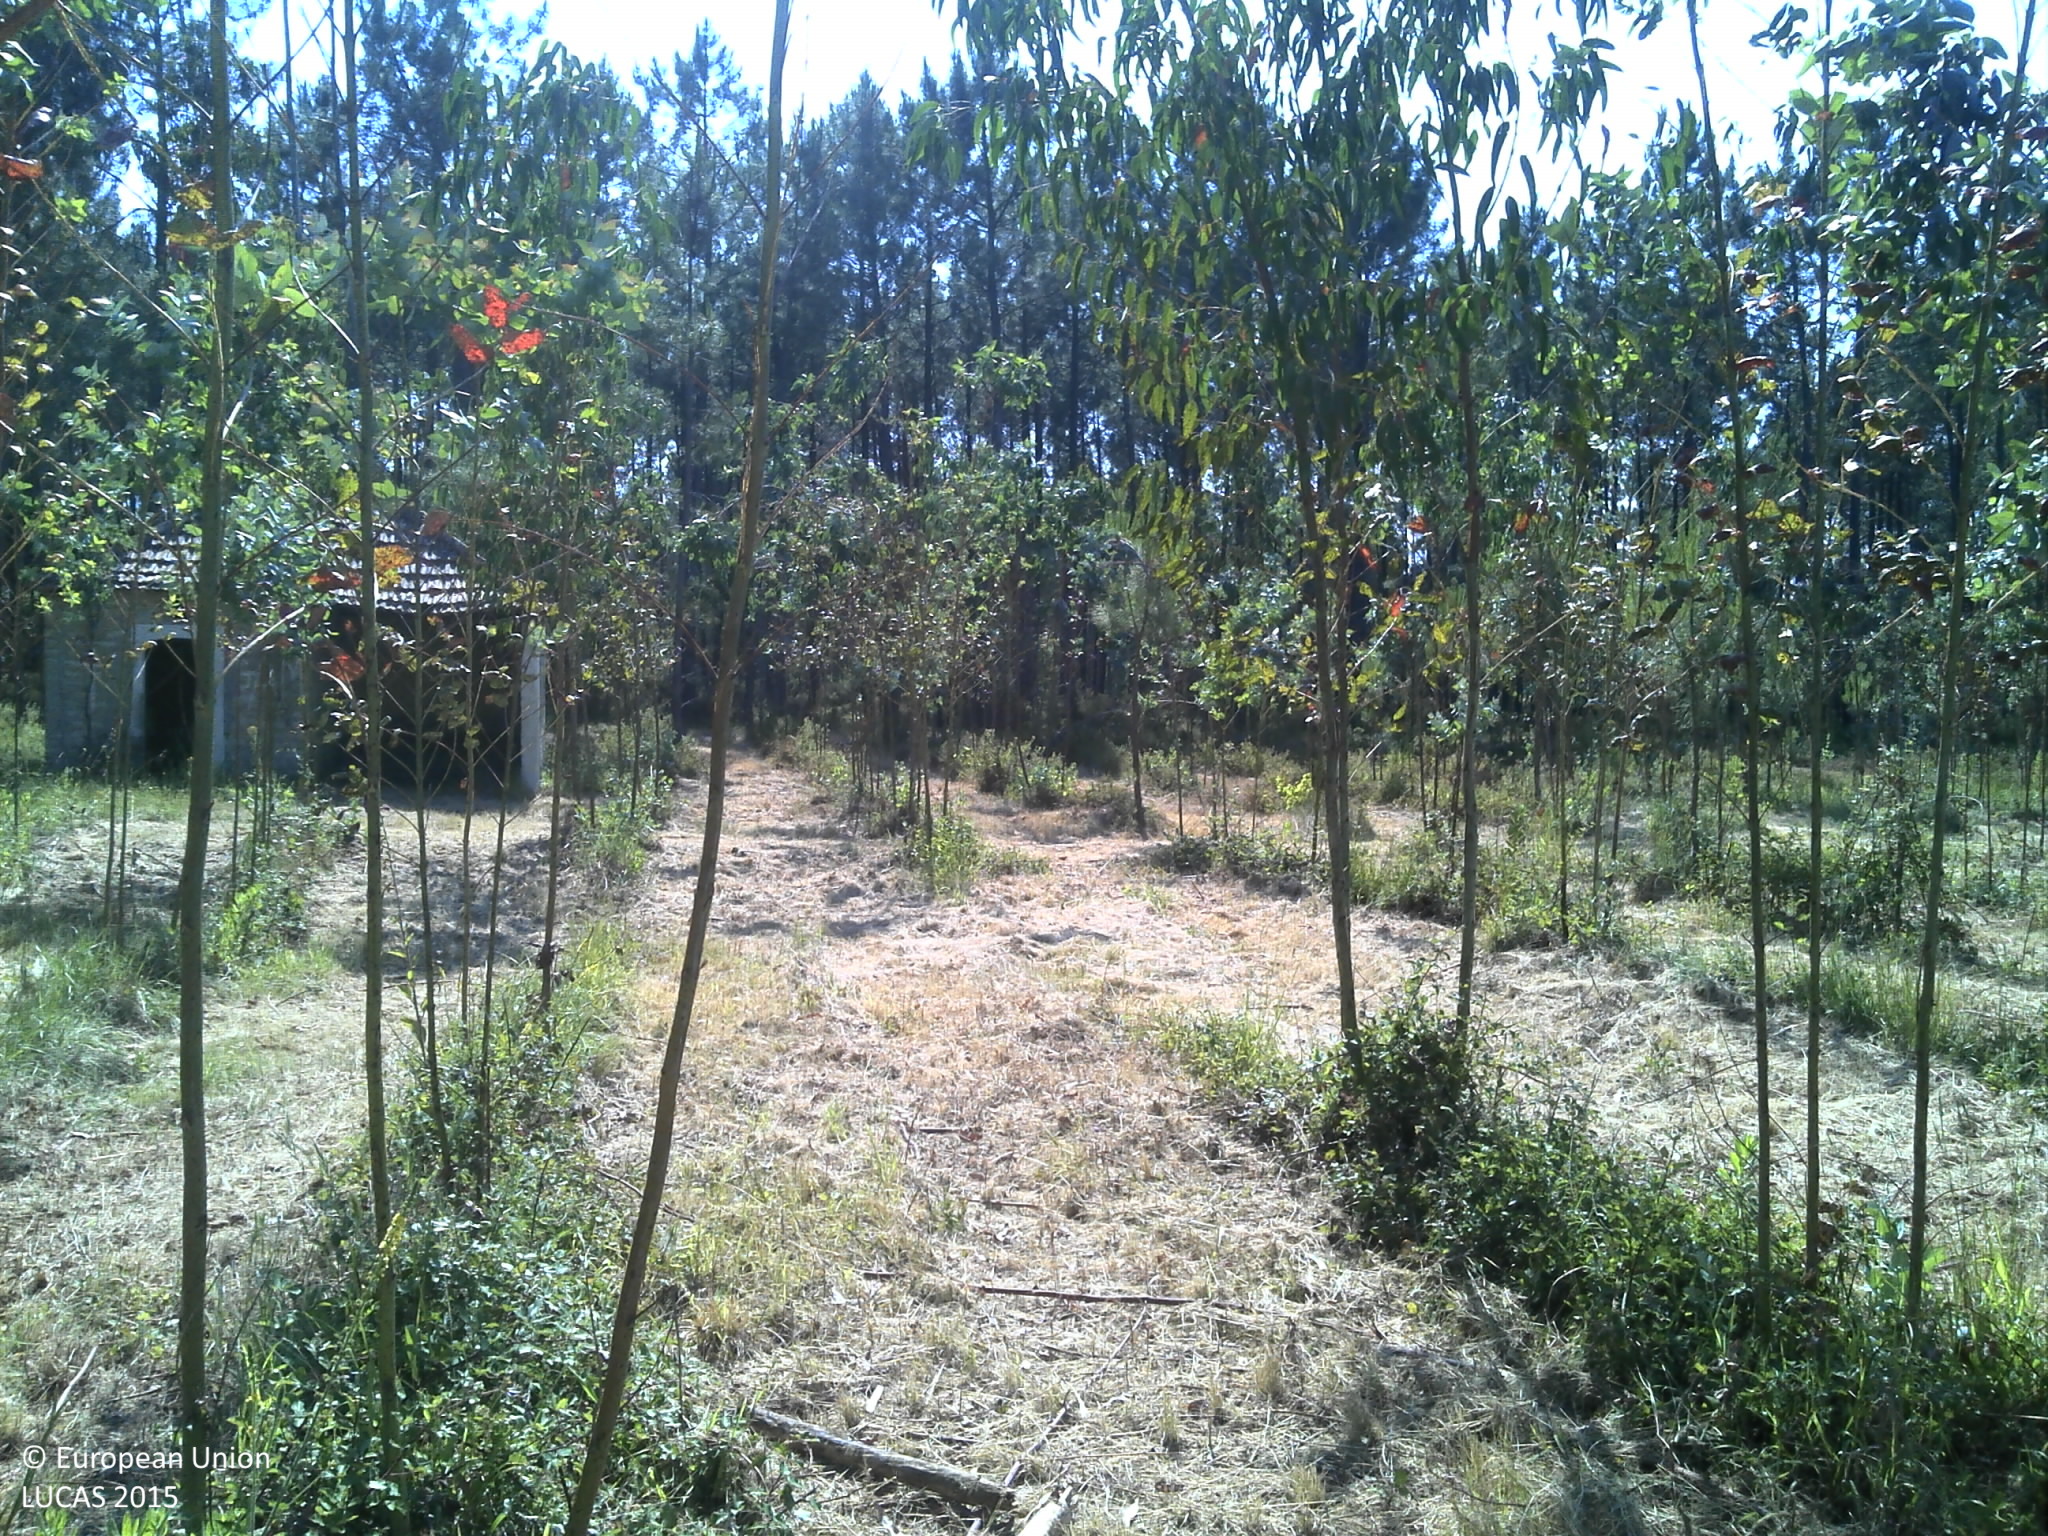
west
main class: Woodland
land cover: Broadleaved woodland
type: exotic forest
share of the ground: 25 - 50 %
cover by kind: broadleaved forest trees 50 %, unconsolidated bare surface 35 %, herbaceous plants 10 %, shrubs 5 %
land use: Forestry
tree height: < 5 m
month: June
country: PT
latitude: 40.3558
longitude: -8.6129
